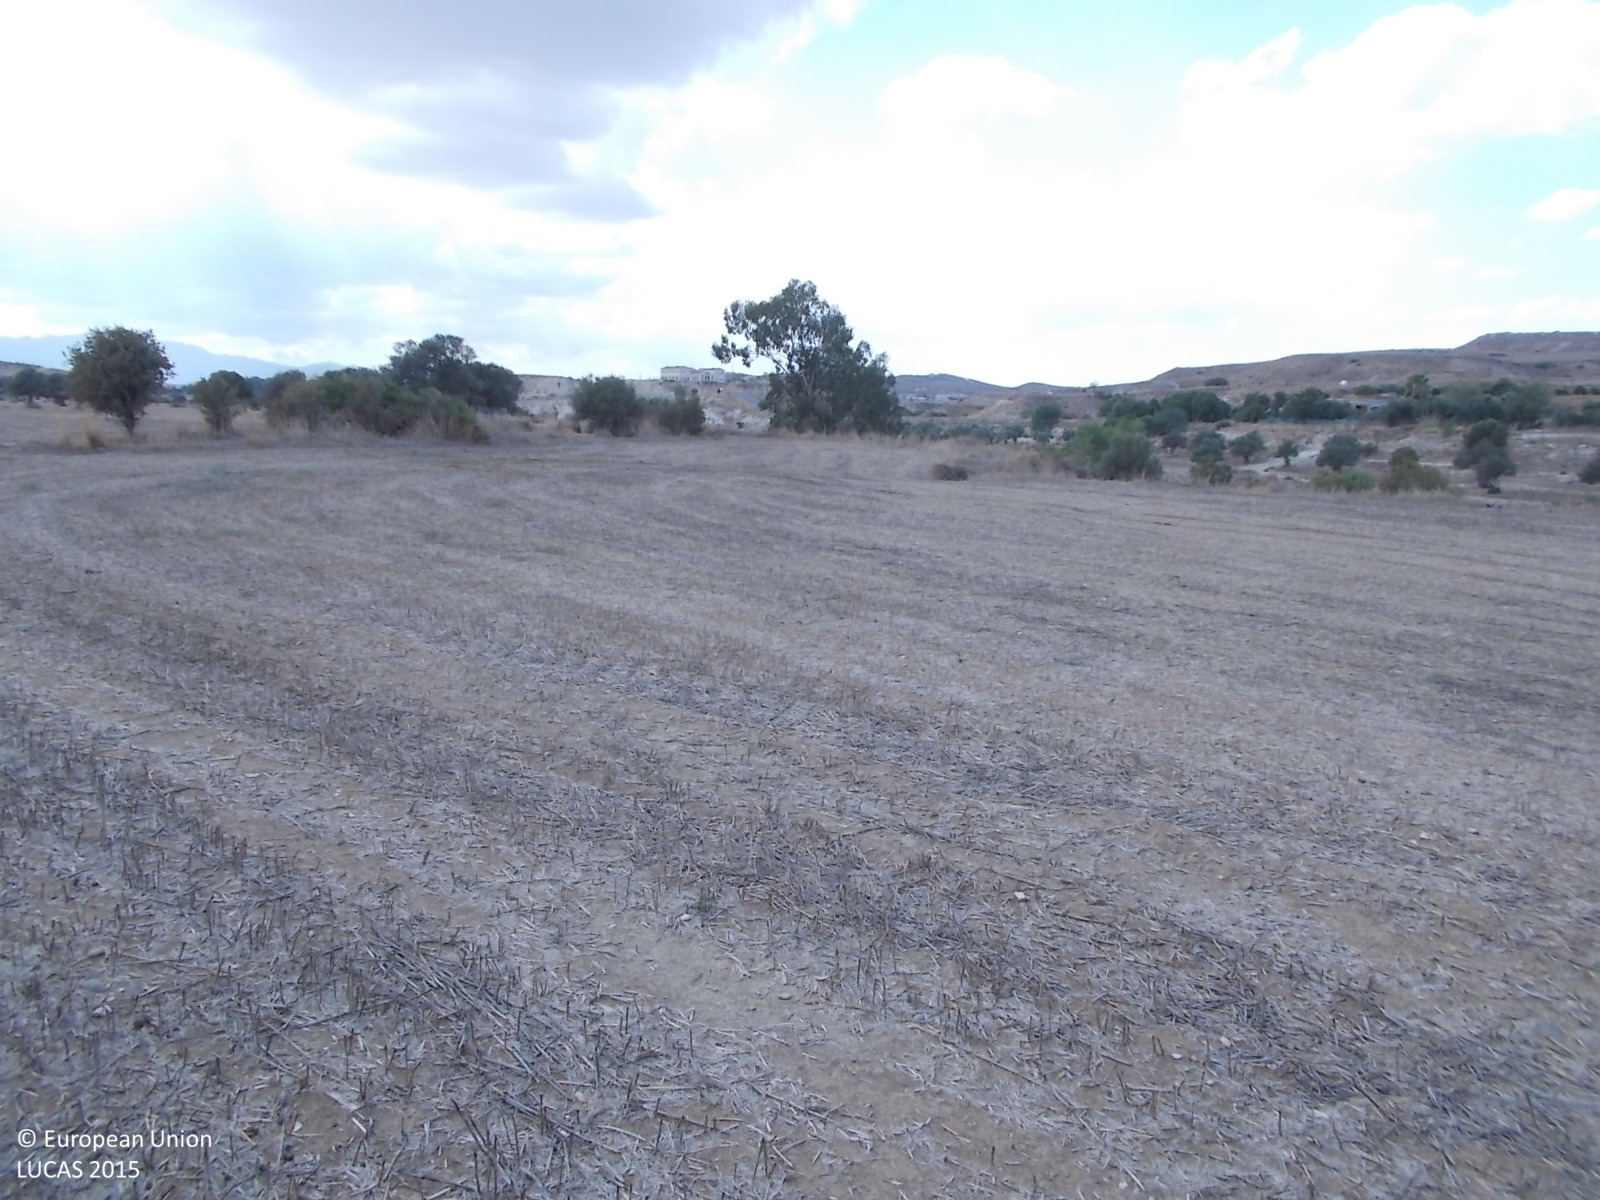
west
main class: Shrubland
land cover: Shrubland without tree cover
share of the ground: > 75 %
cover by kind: shrubs 60 %, herbaceous plants 40 %
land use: Semi-natural and natural areas not in use
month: April
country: CY
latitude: 35.0182
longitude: 33.3678
